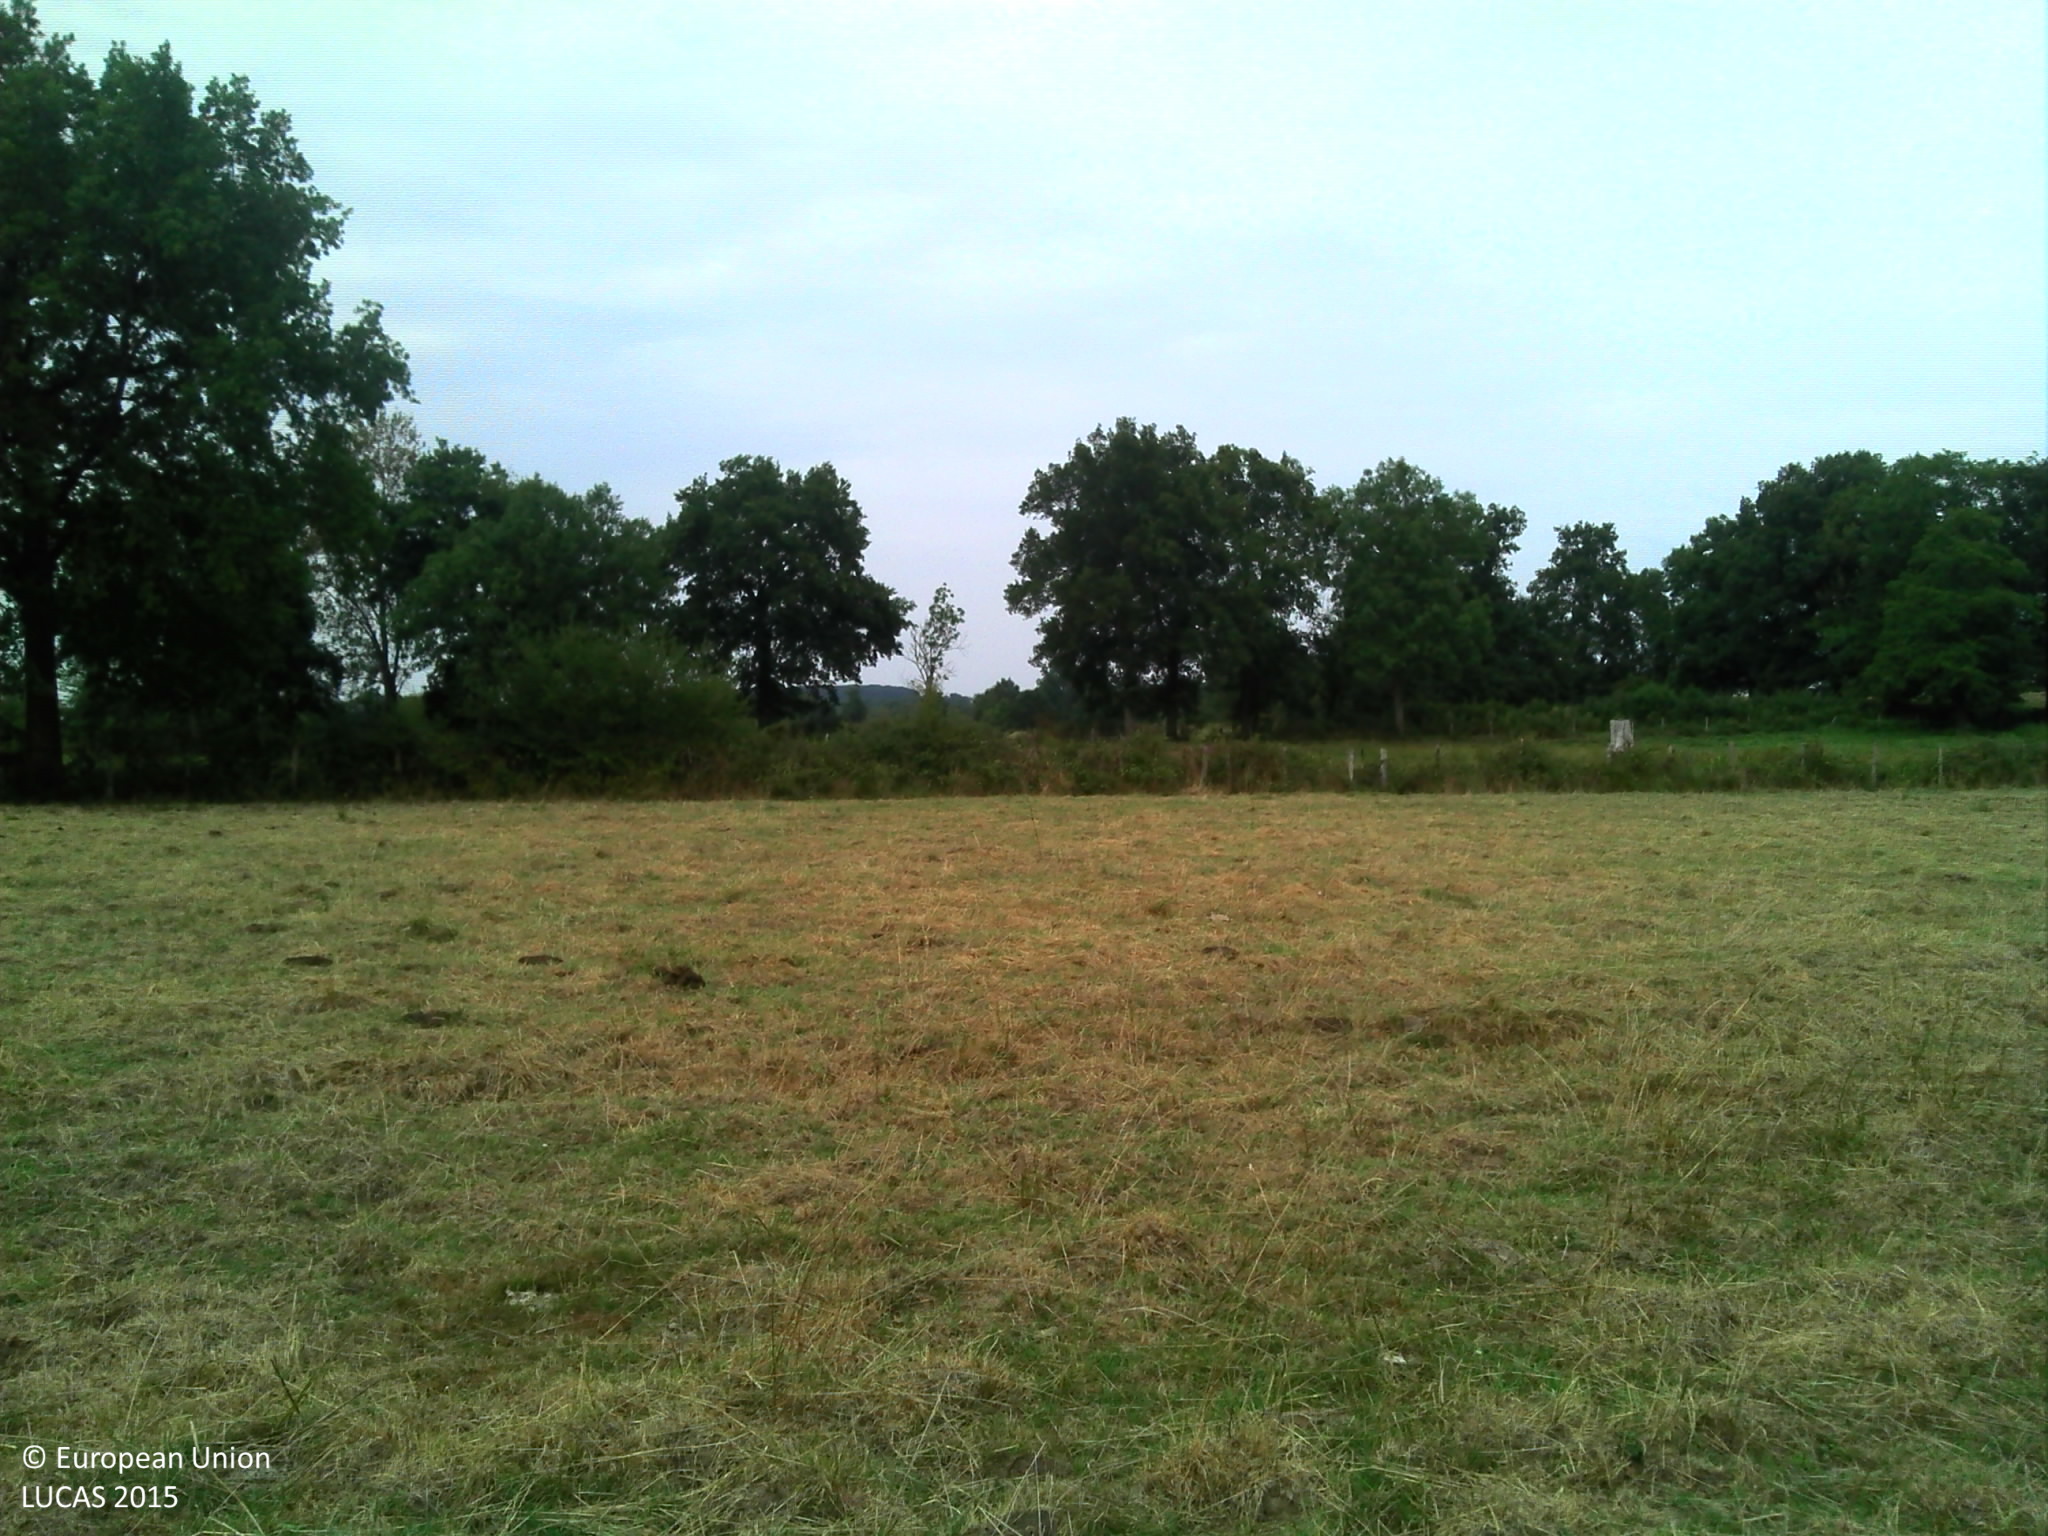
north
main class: Grassland
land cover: Grassland without tree/shrub cover
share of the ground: > 75 %
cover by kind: herbaceous plants 100 %
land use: Agriculture (excluding fallow land and kitchen gardens)
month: August
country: FR
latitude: 46.2696
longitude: 3.6289
